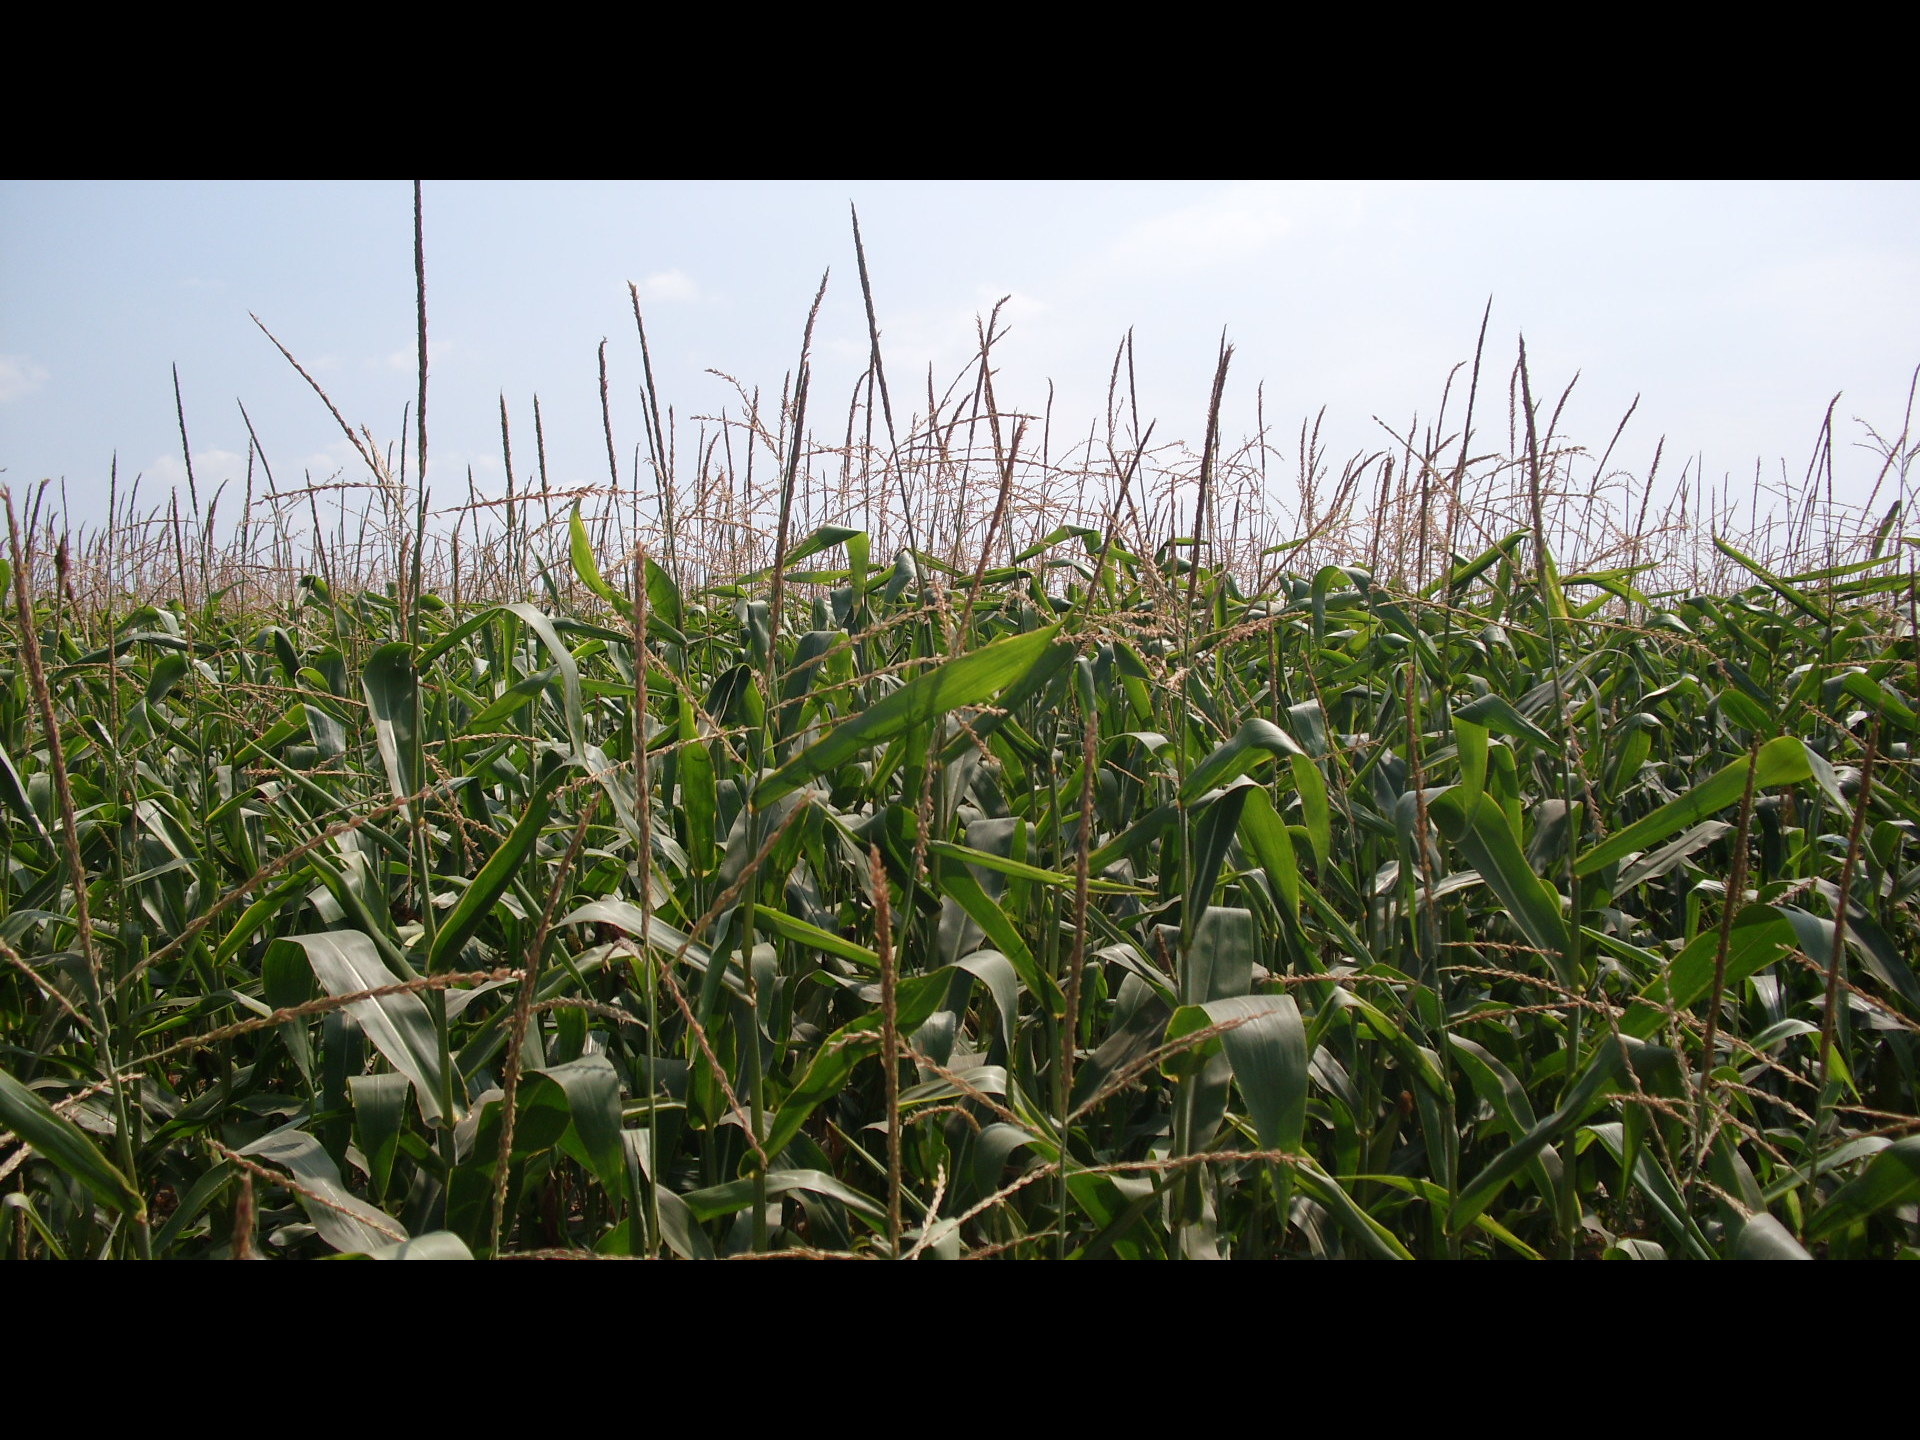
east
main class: Cropland
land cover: Maize
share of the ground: > 75 %
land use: Agriculture (excluding fallow land and kitchen gardens)
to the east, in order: Maize
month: August
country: BG
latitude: 43.7014
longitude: 23.6363
